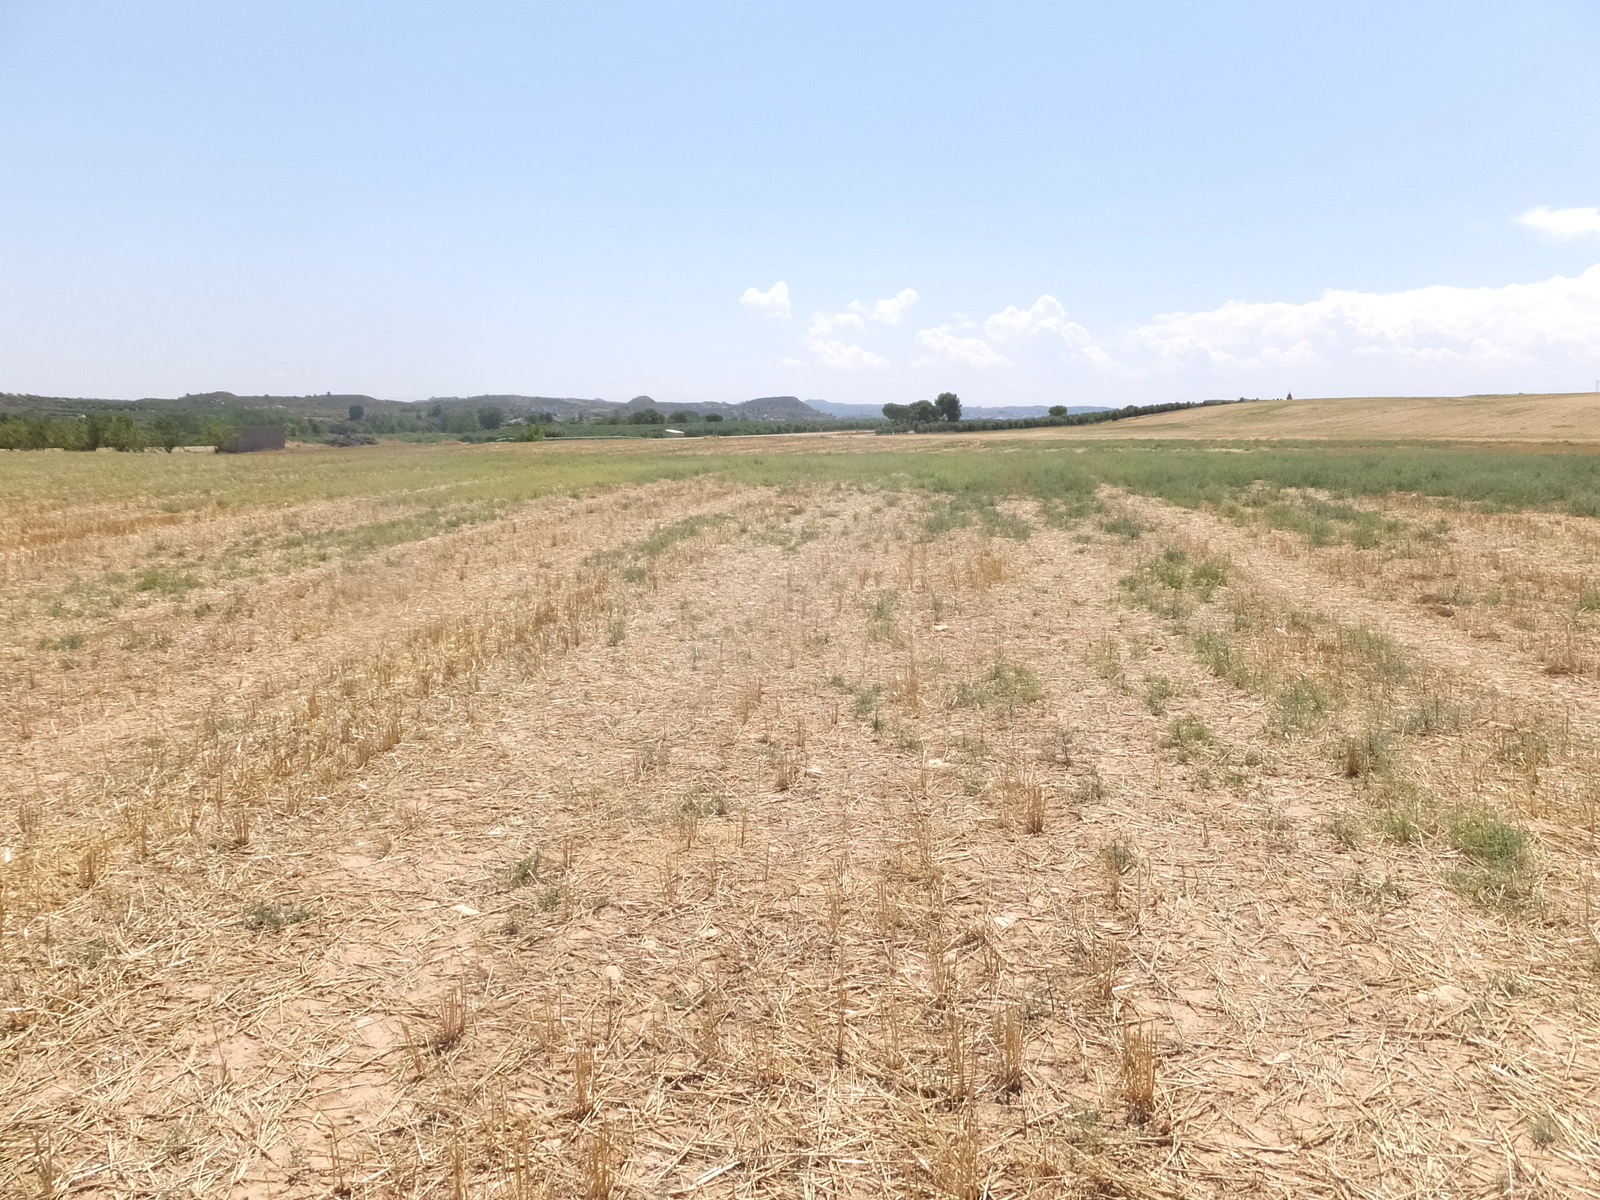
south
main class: Cropland
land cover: Barley
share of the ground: < 10 %
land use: Agriculture (excluding fallow land and kitchen gardens)
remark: Harvested field
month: July
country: ES
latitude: 41.1706
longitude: 0.1317
